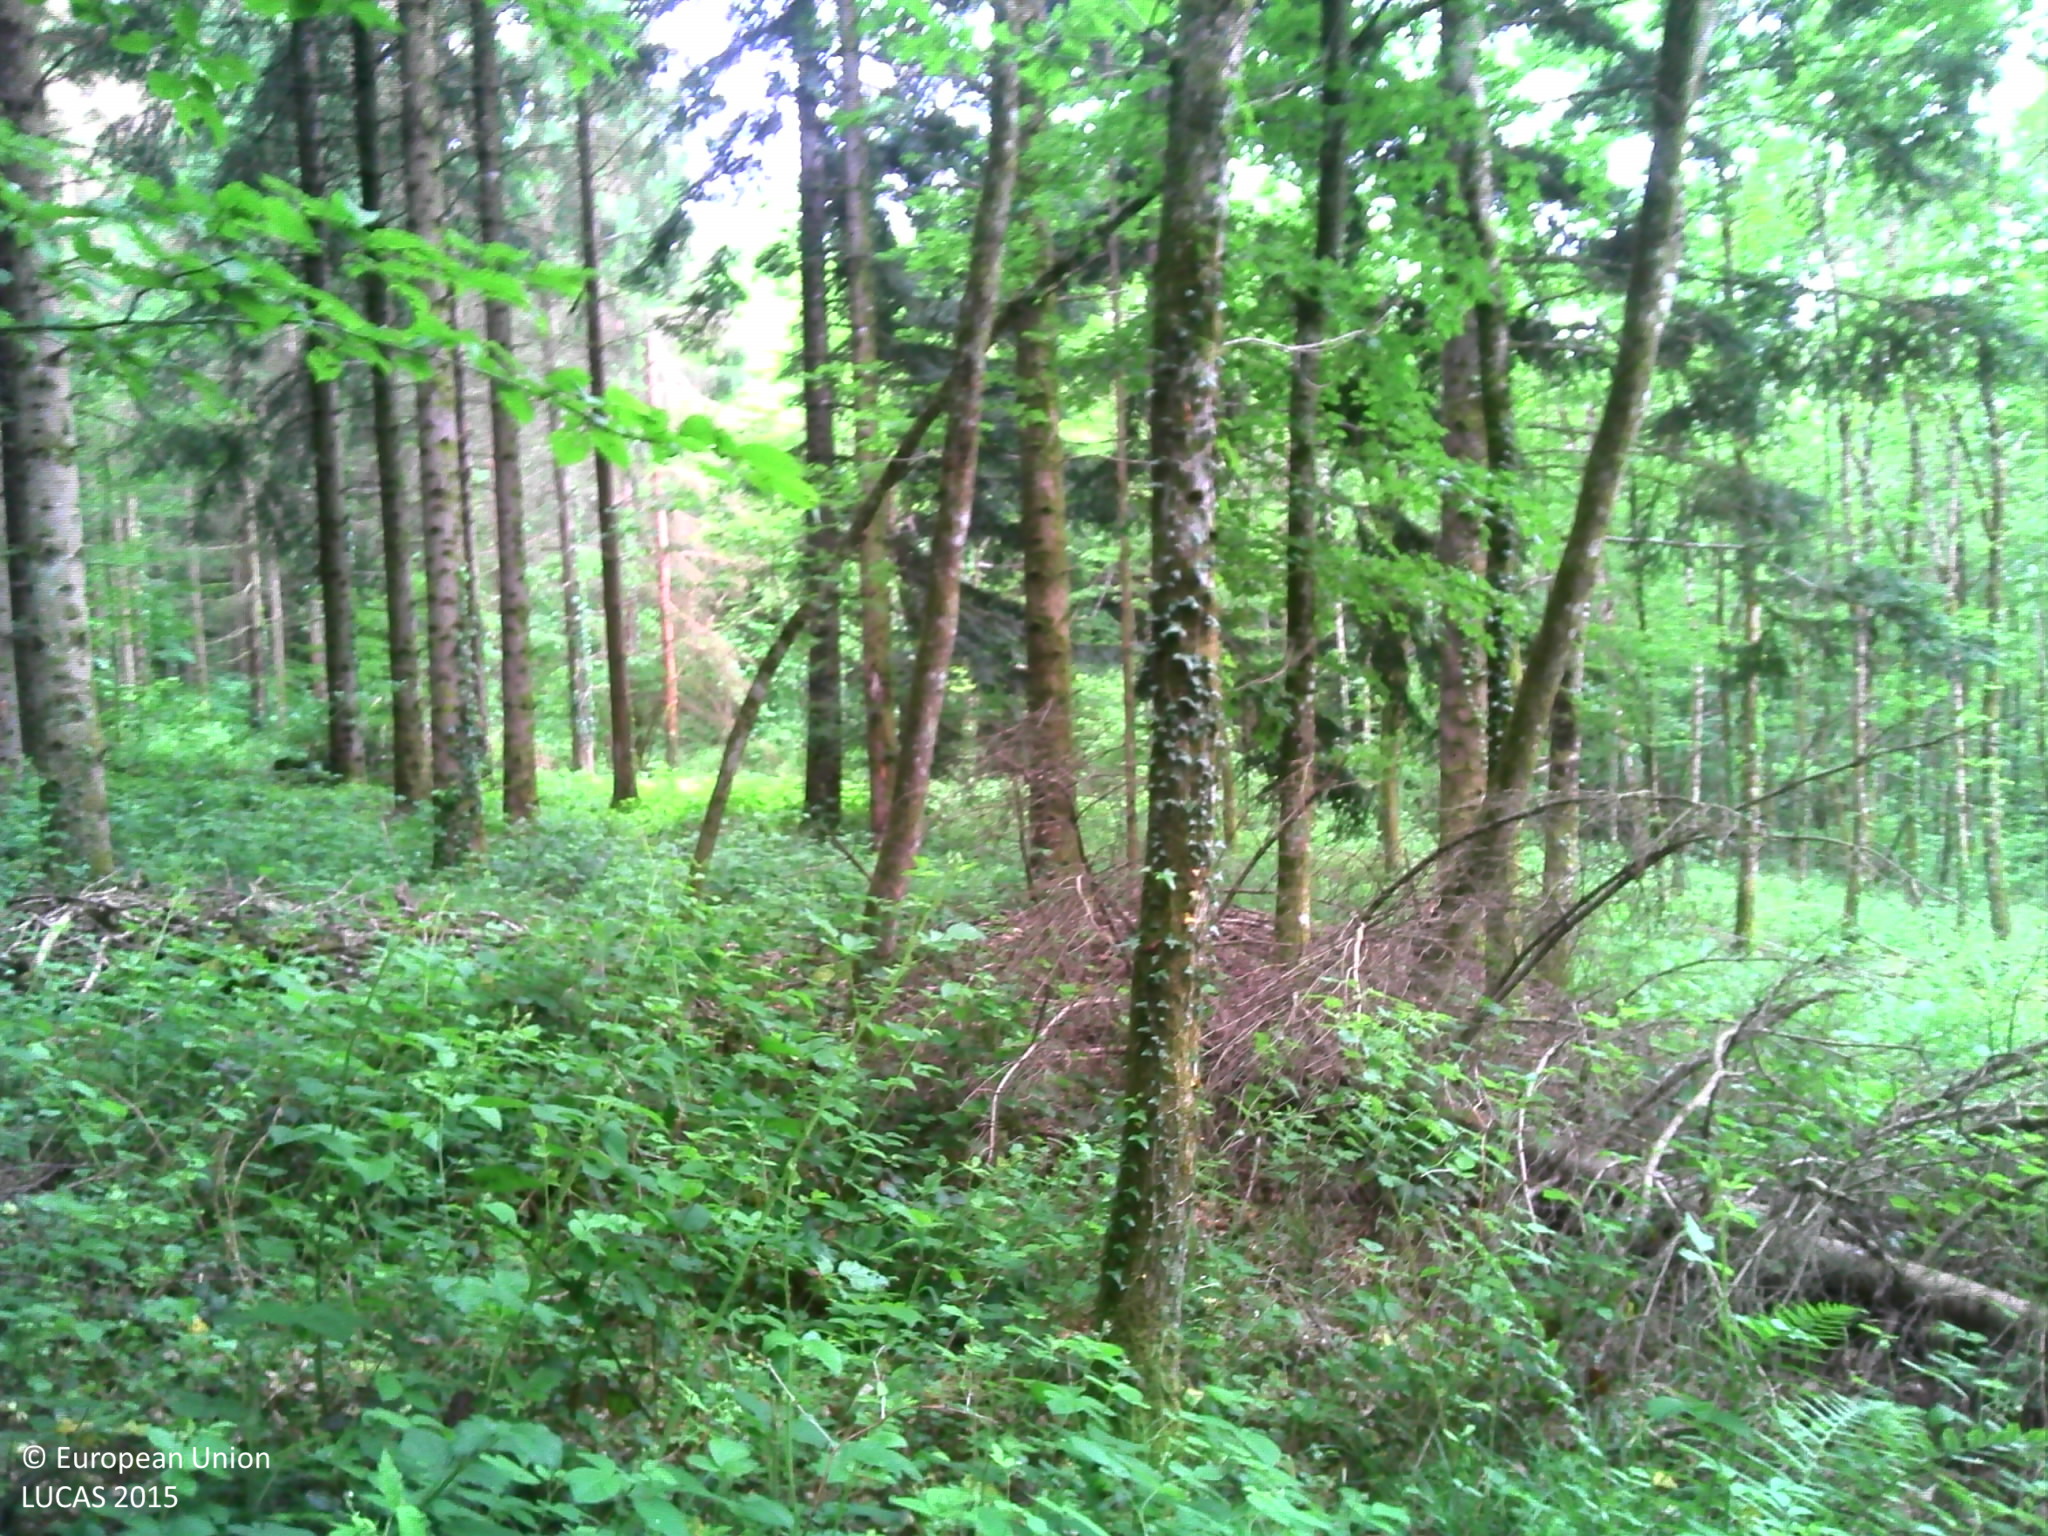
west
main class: Woodland
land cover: Broadleaved woodland
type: beech forest
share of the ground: > 75 %
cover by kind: broadleaved forest trees 90 %, herbaceous plants 10 %
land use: Forestry
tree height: > 5 m
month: May
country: FR
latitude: 47.8629
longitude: 6.0040
